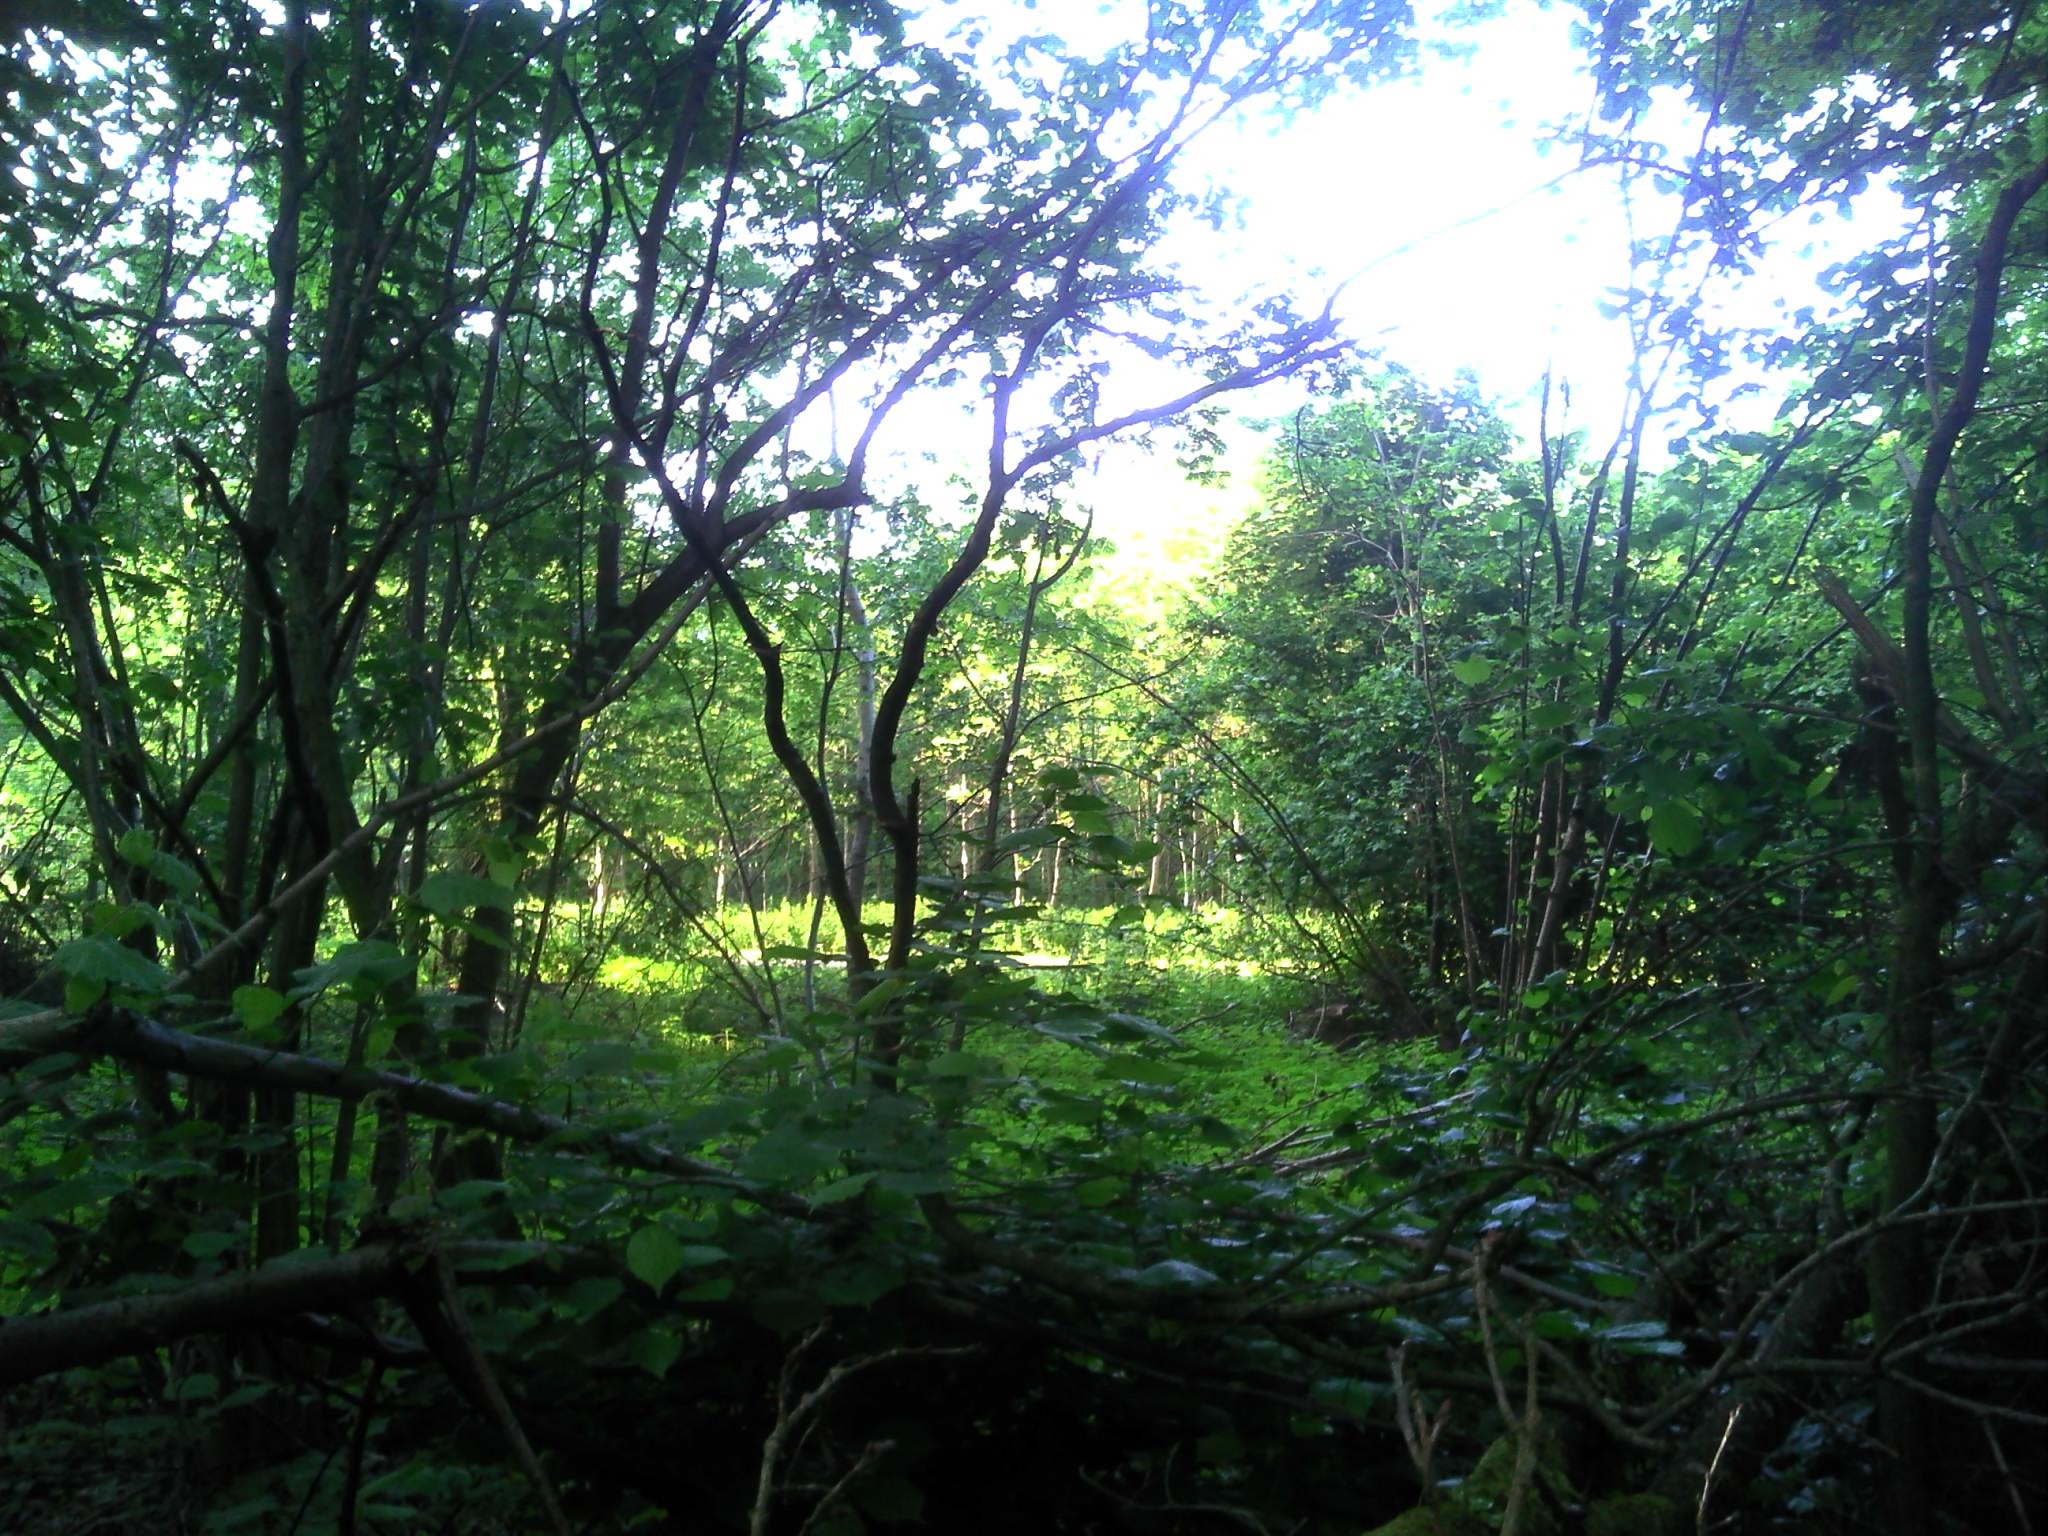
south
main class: Woodland
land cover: Broadleaved woodland
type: mesophytic deciduous forest
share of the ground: > 75 %
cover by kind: broadleaved forest trees 85 %, herbaceous plants 15 %
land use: Forestry
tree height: > 5 m
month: June
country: BE
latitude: 50.5875
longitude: 4.7847
